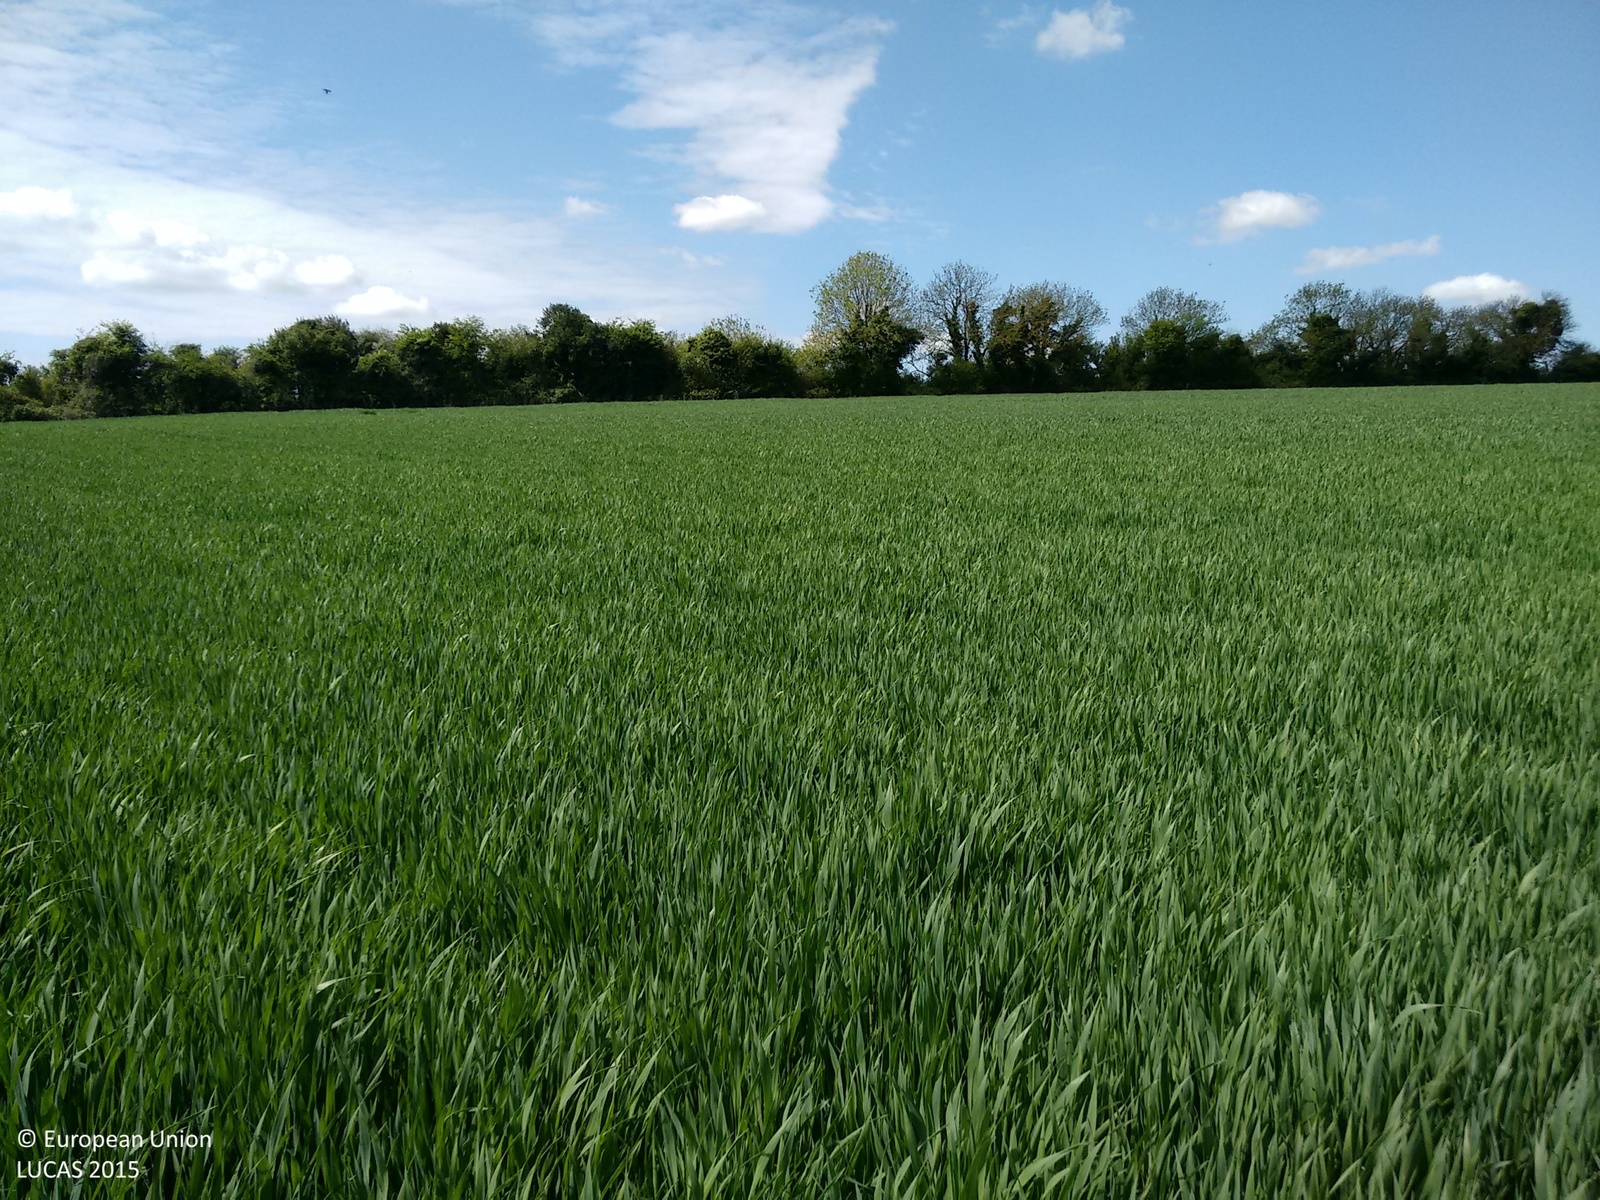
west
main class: Cropland
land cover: Common wheat
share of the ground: > 75 %
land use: Agriculture (excluding fallow land and kitchen gardens)
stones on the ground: > 50 %
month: May
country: GB
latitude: 50.9036
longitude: -2.0755
